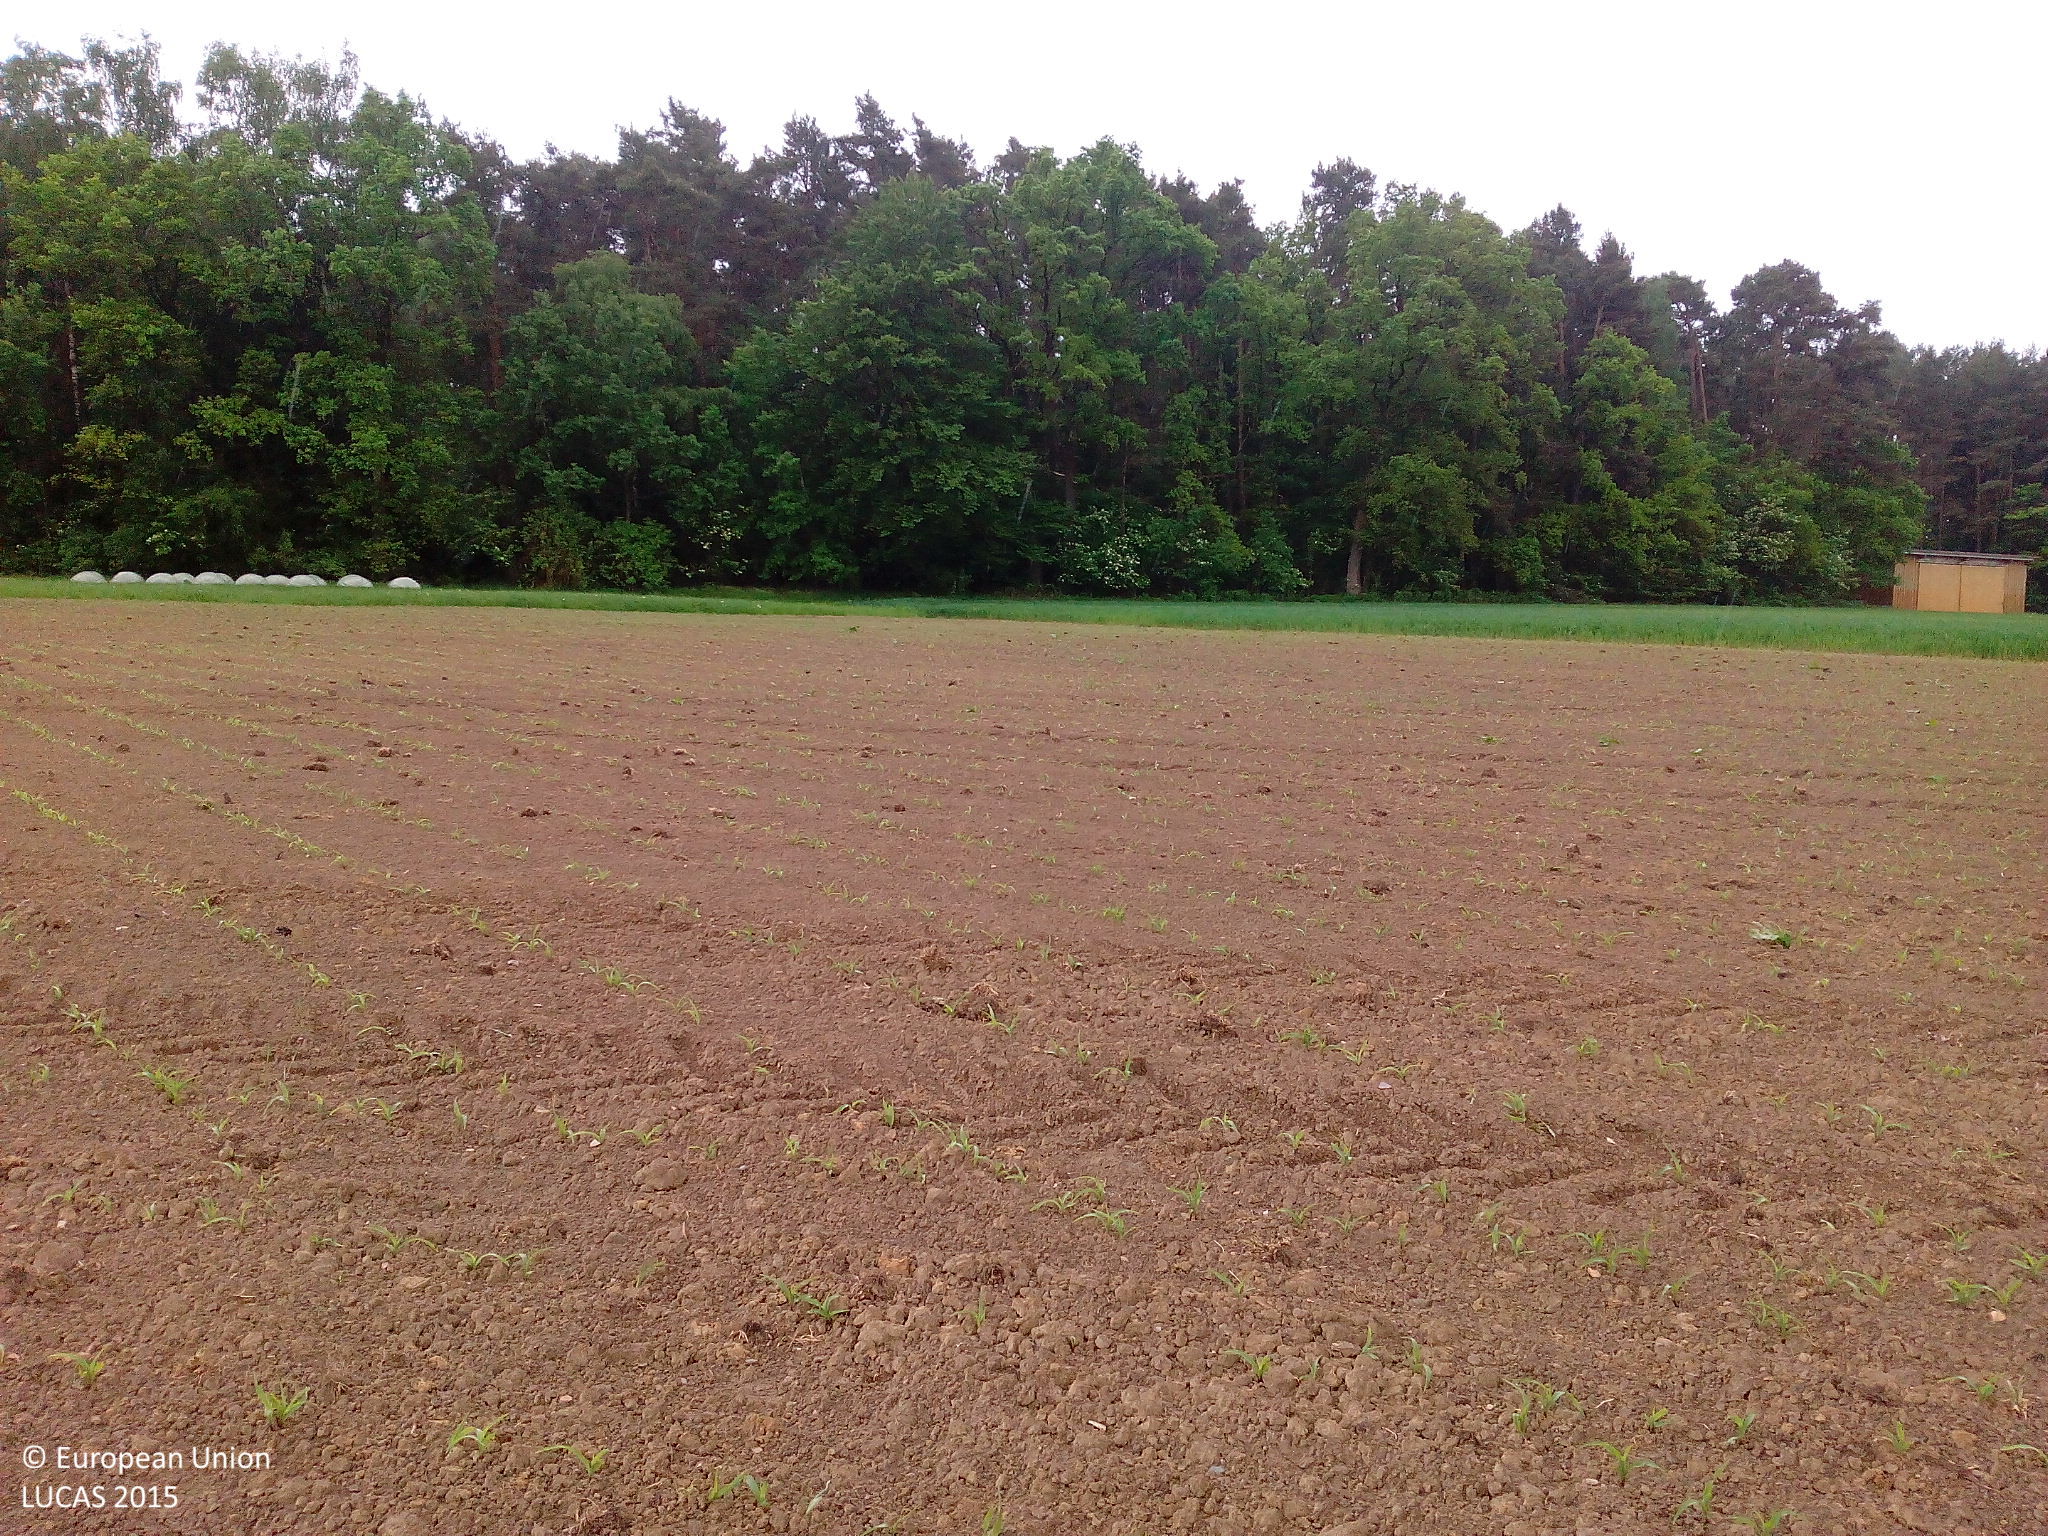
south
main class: Cropland
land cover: Maize
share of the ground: < 10 %
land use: Agriculture (excluding fallow land and kitchen gardens)
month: May
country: DE
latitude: 49.3113
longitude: 11.4713
